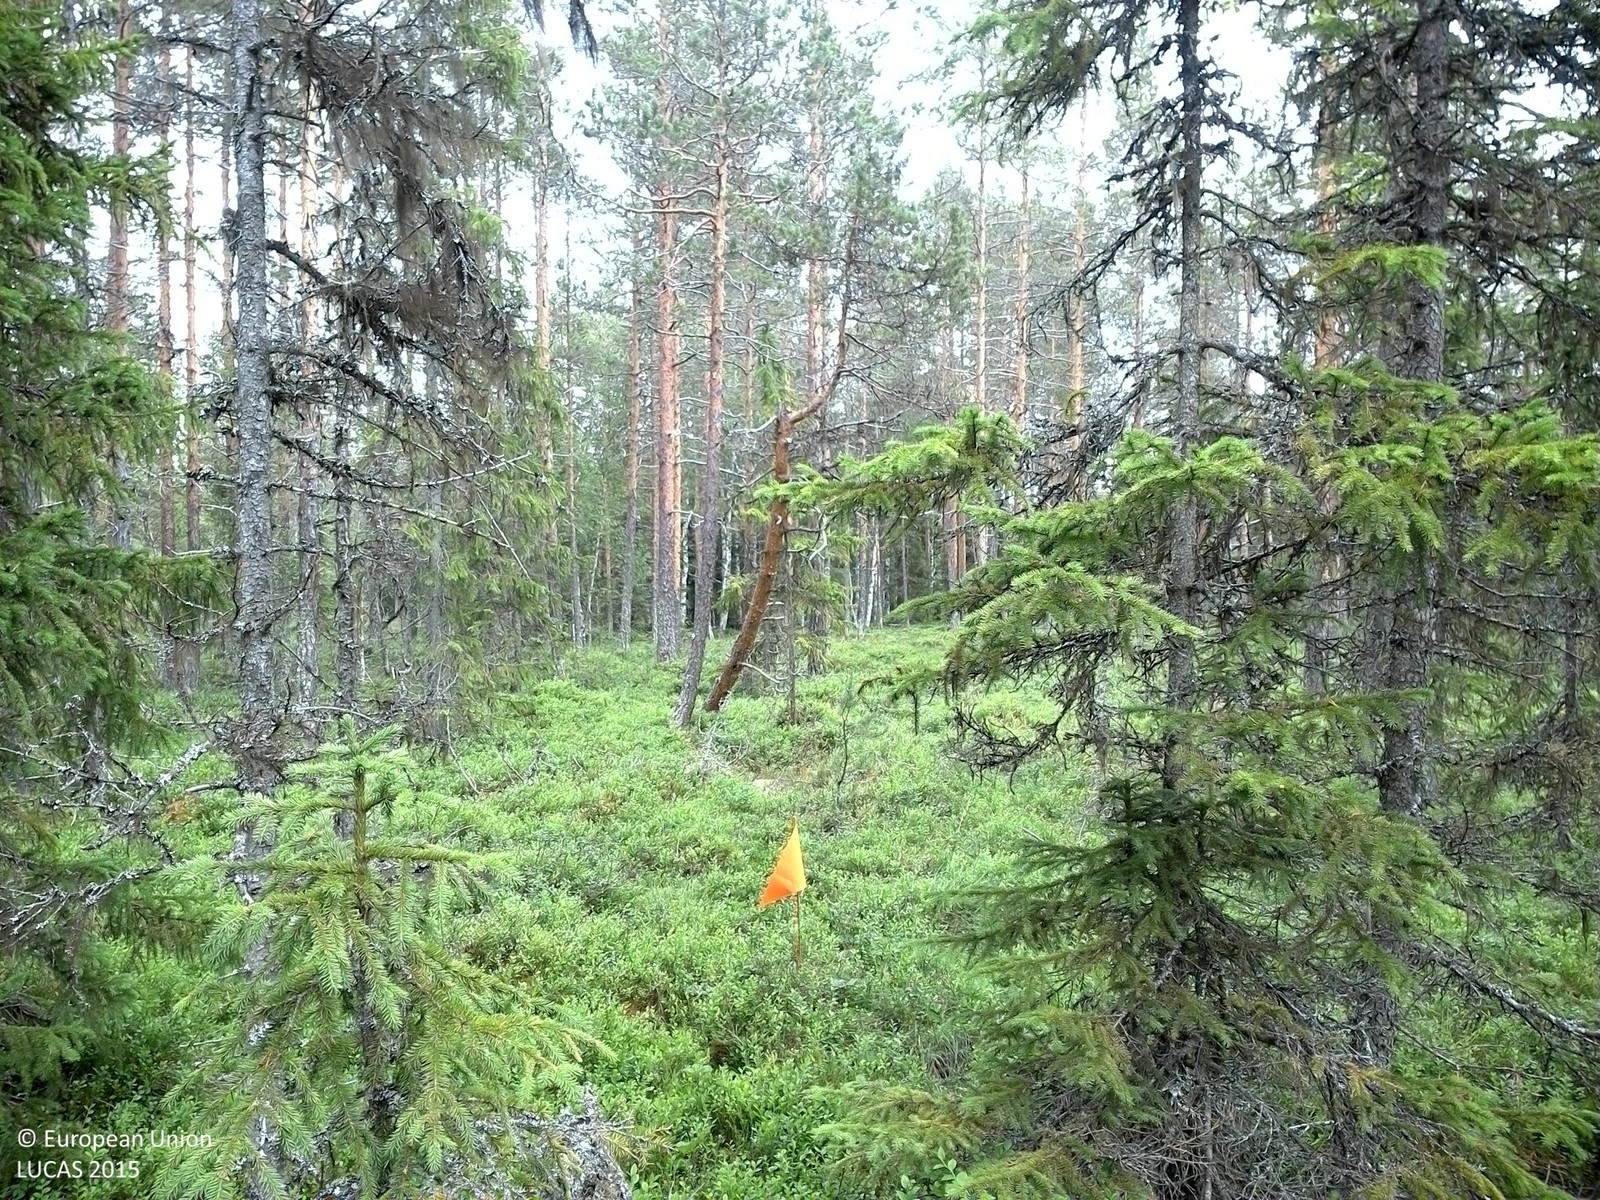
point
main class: Woodland
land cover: Pine dominated coniferous woodland
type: boreal forest
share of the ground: 25 - 50 %
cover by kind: shrubs 50 %, coniferous forest trees 35 %, broadleaved forest trees 5 %, herbaceous plants 5 %, lichens and mosses 5 %
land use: Forestry
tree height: > 5 m
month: July
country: SE
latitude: 62.8341
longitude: 16.9078
